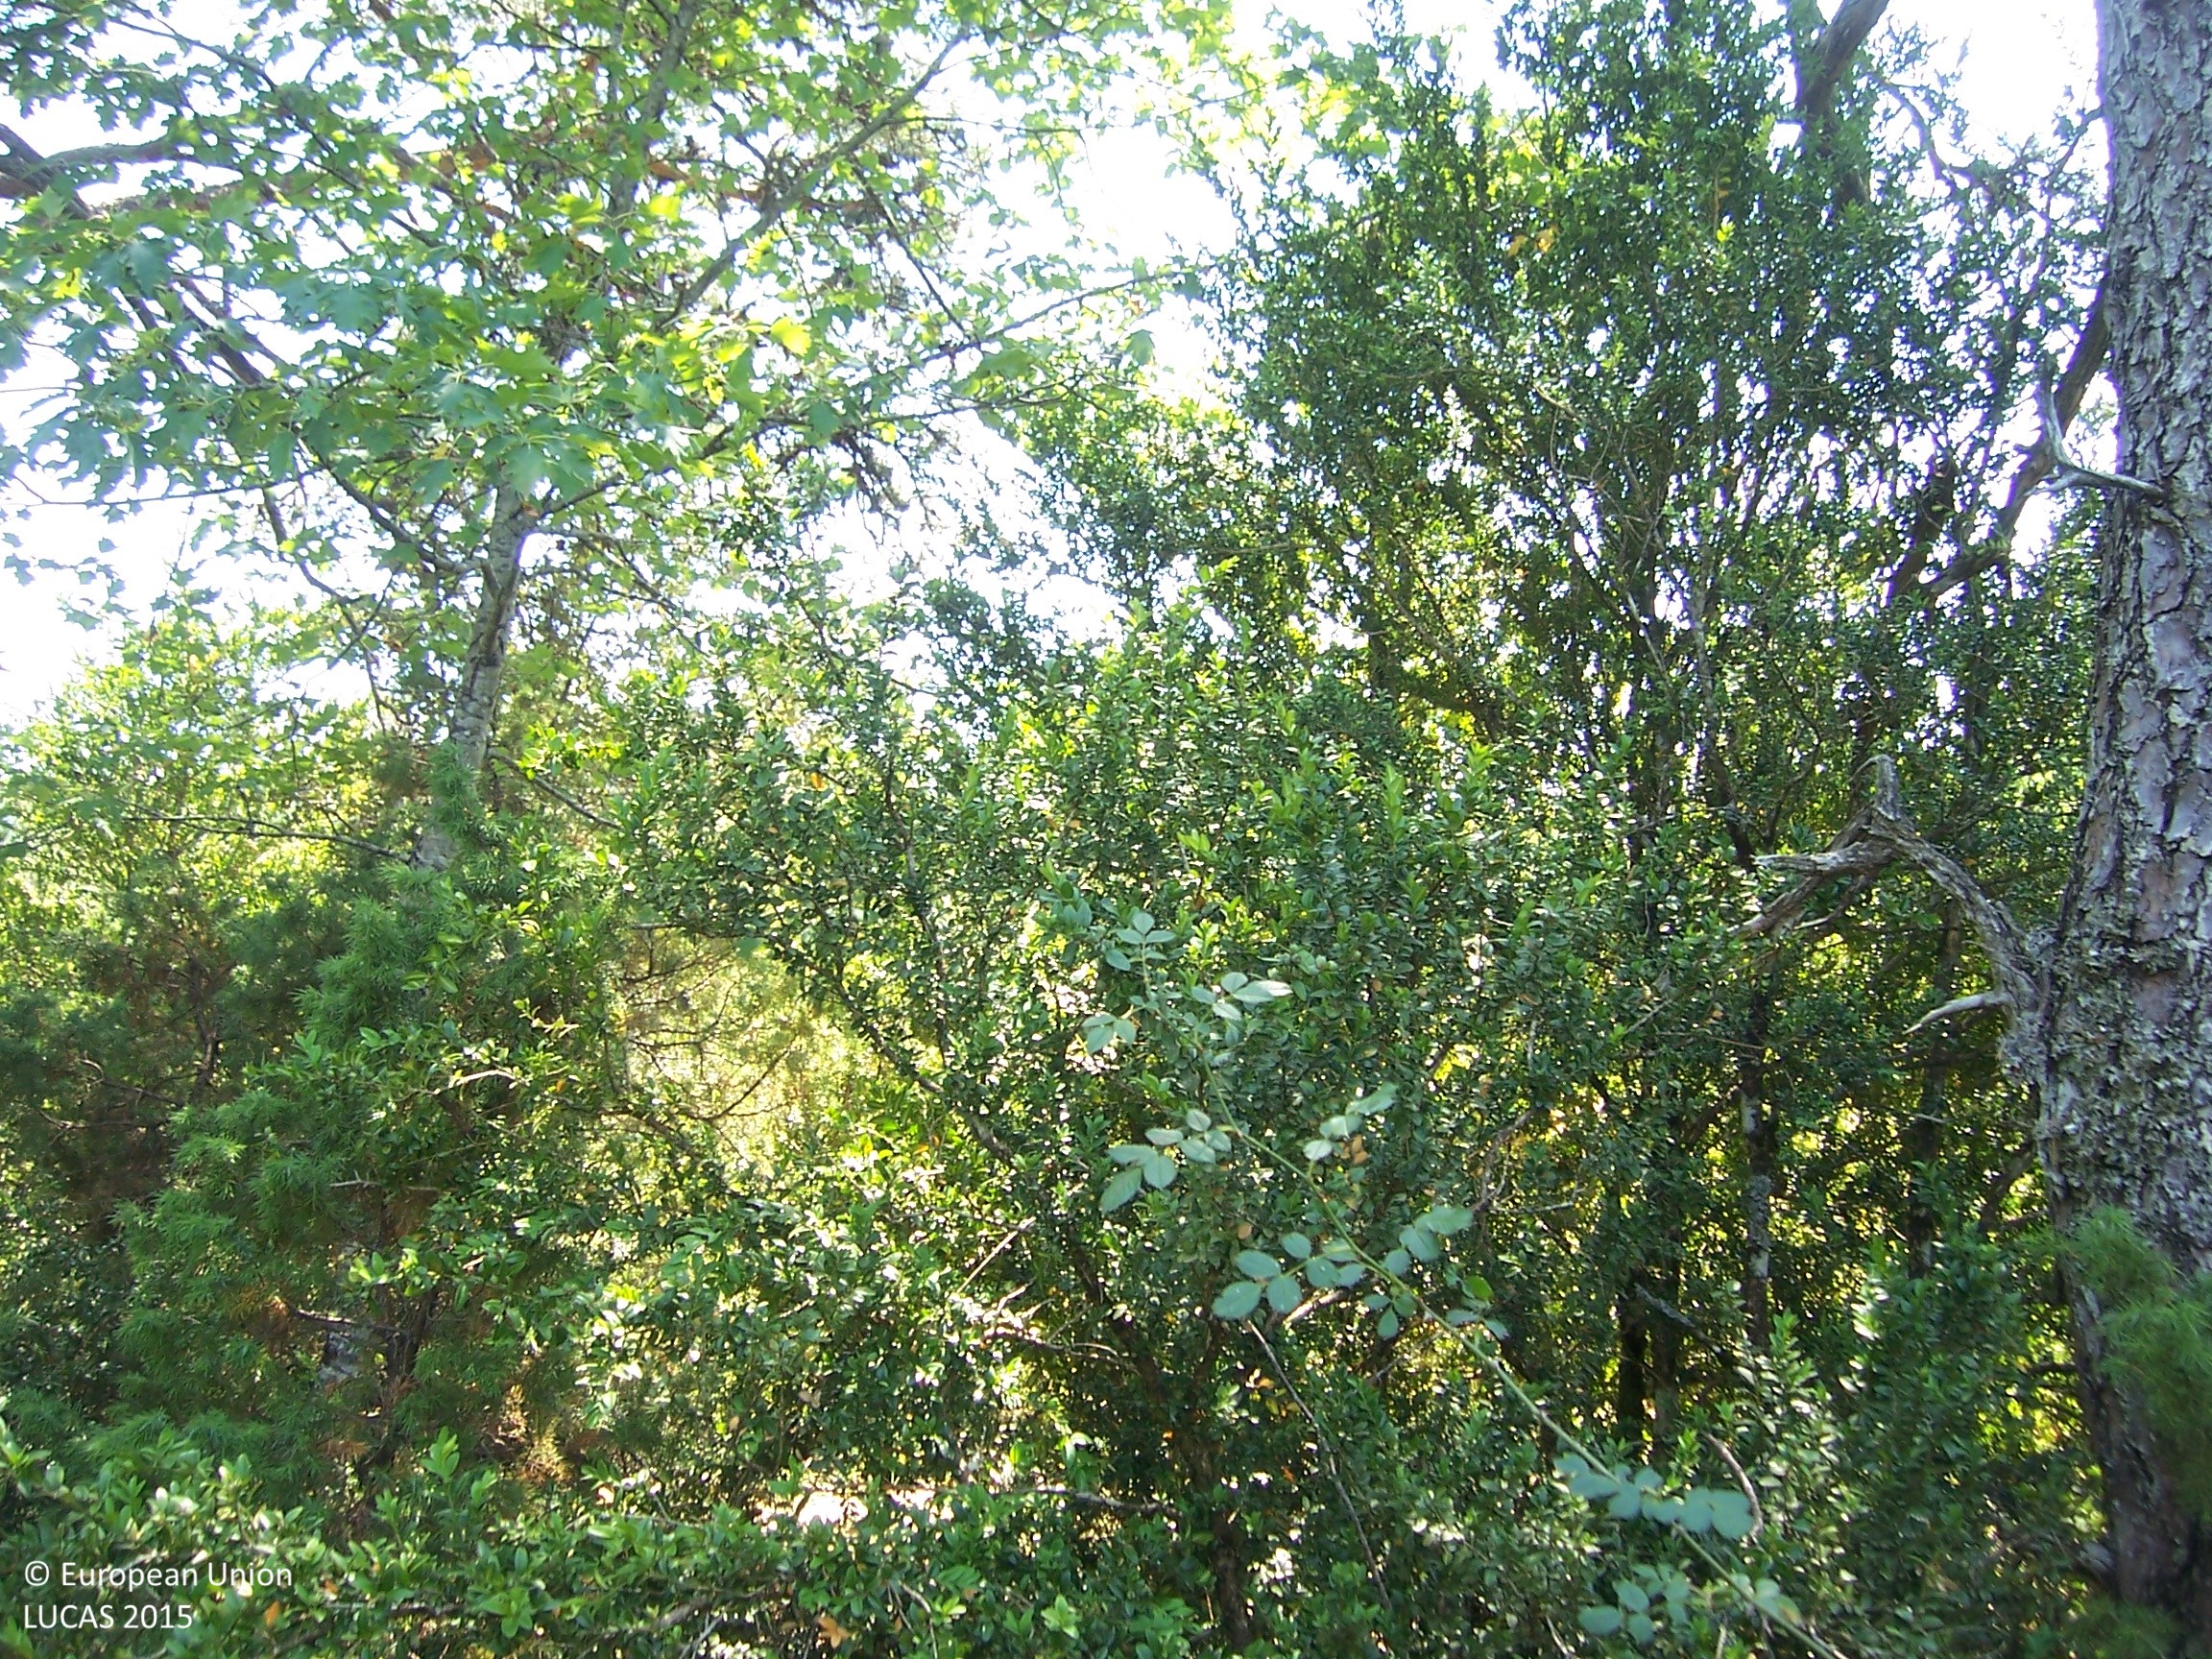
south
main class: Woodland
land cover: Pine dominated mixed woodland
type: coniferous forest of the mediterranean region
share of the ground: > 75 %
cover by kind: coniferous forest trees 75 %, broadleaved forest trees 25 %
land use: Forestry
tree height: > 5 m
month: July
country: ES
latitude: 42.8415
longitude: -1.2800
